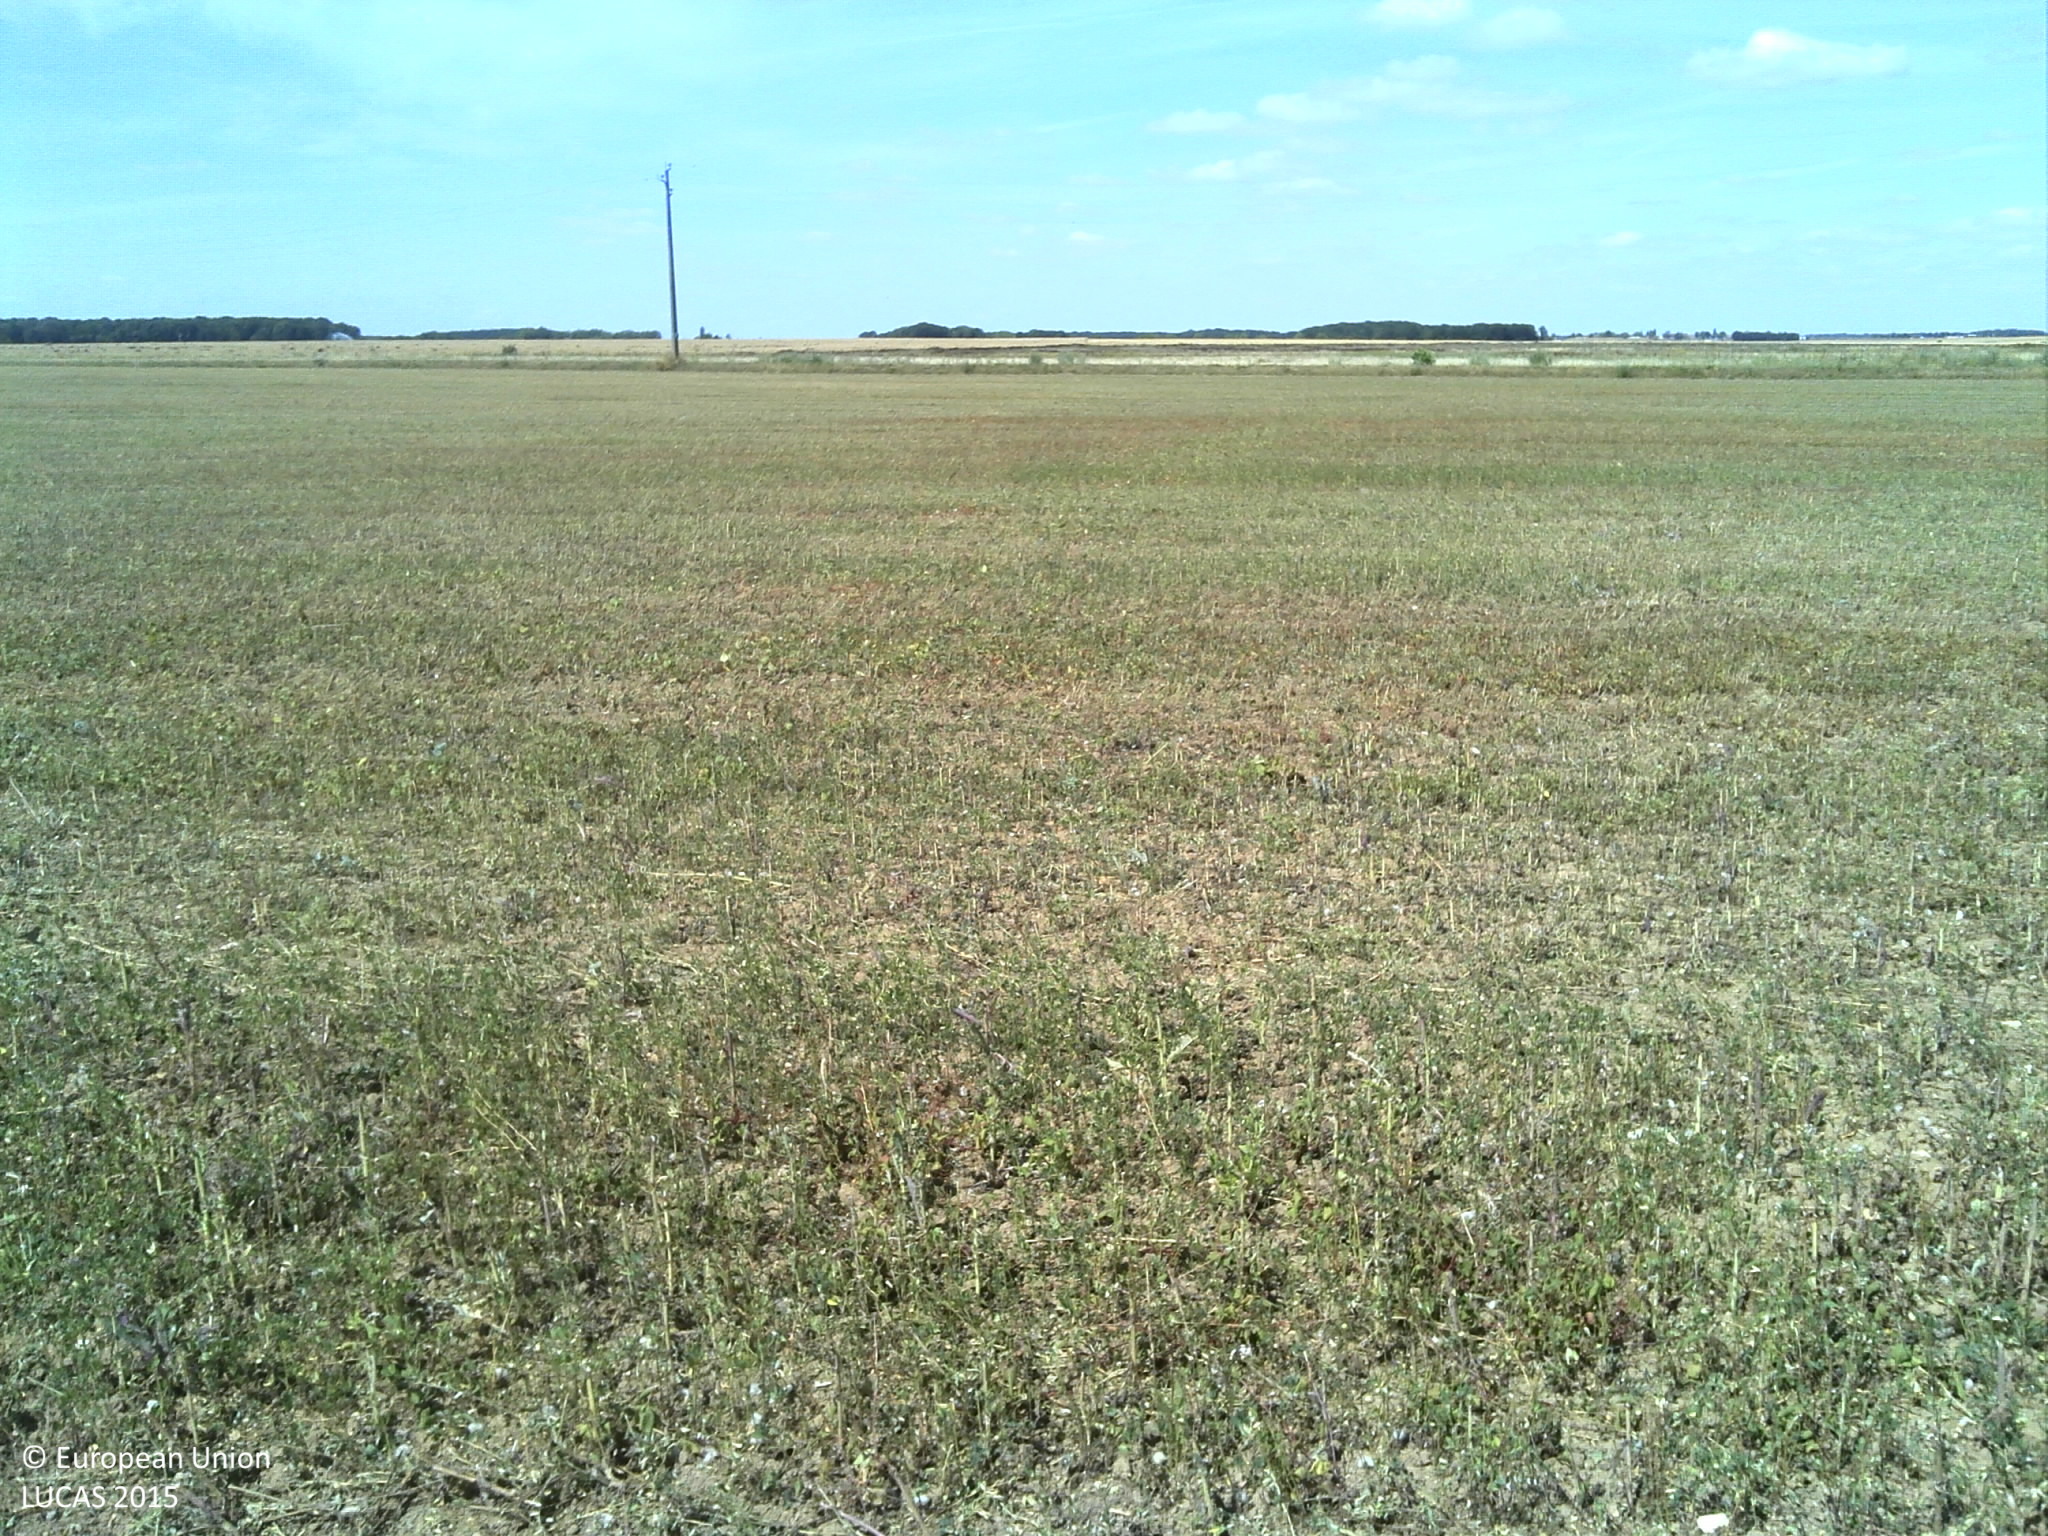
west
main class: Cropland
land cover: Temporary grasslands
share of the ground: > 75 %
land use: Agriculture (excluding fallow land and kitchen gardens)
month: July
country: FR
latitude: 48.5558
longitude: 1.8699
